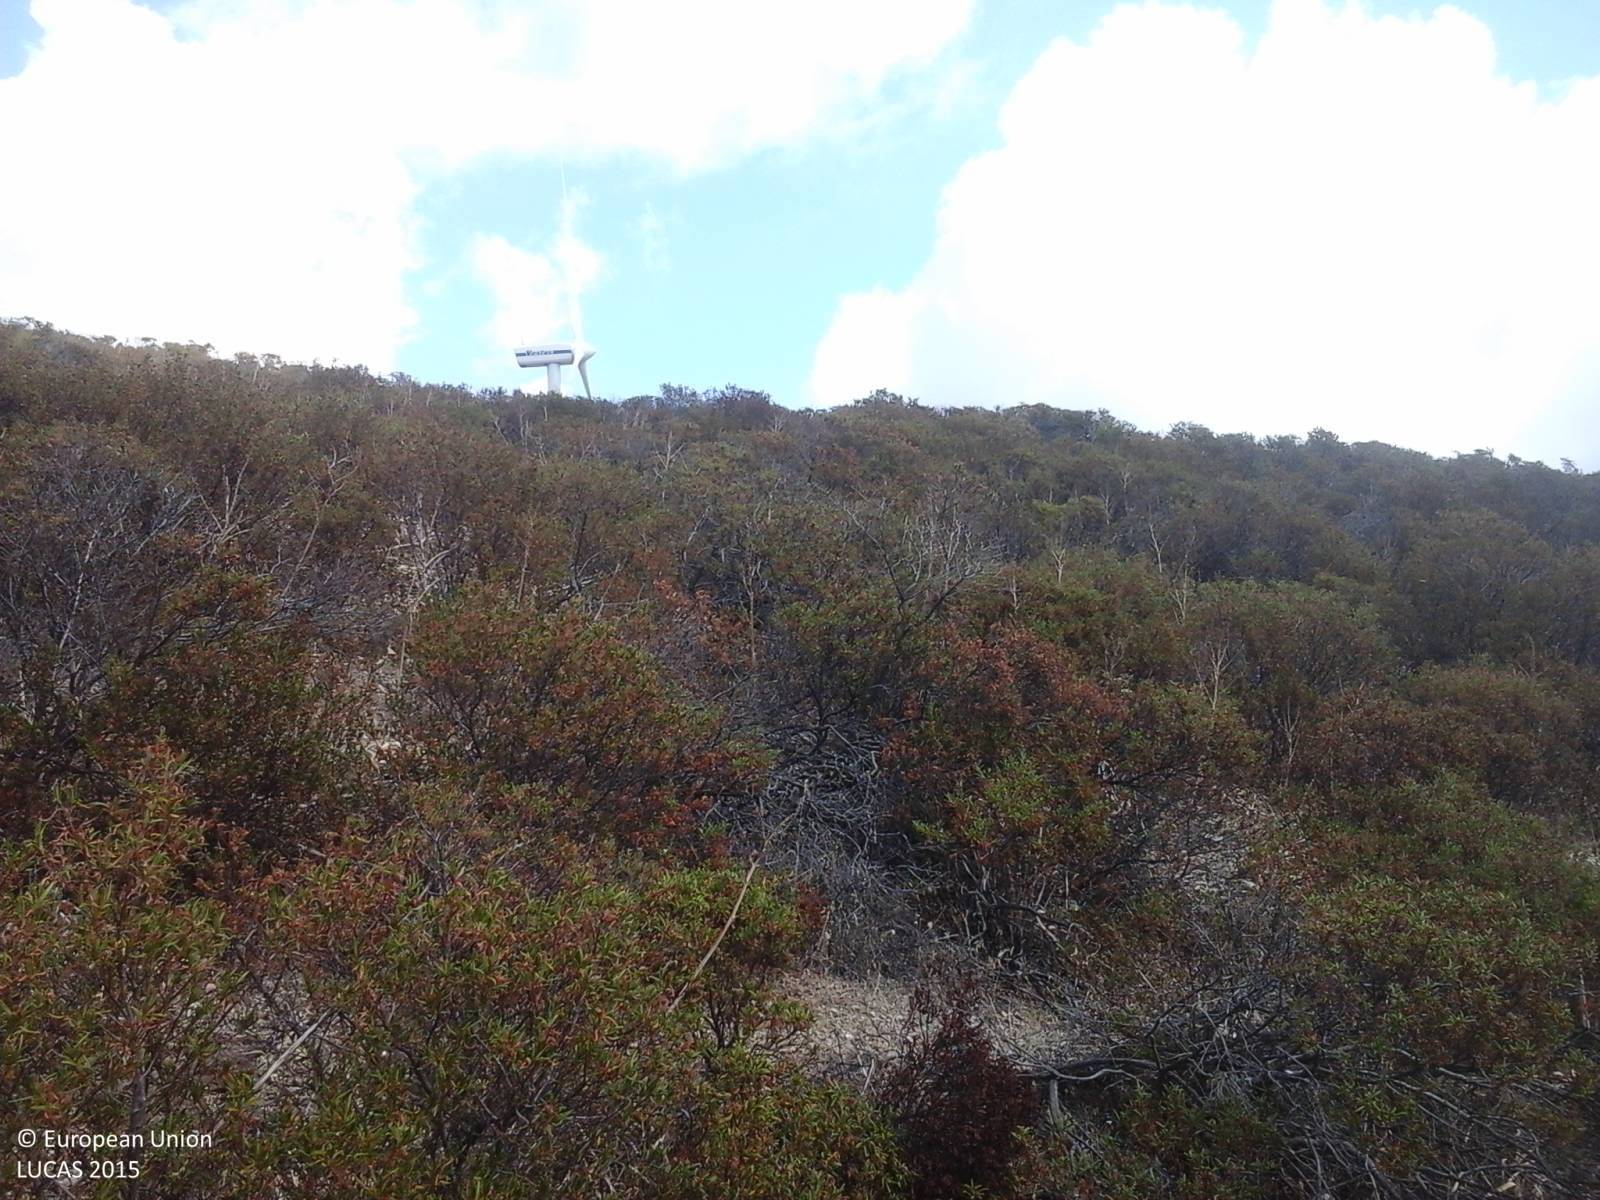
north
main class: Shrubland
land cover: Shrubland without tree cover
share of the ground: > 75 %
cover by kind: shrubs 80 %, herbaceous plants 10 %, unconsolidated bare surface 10 %
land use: Agriculture (excluding fallow land and kitchen gardens)
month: August
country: IT
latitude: 39.7048
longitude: 9.5246
